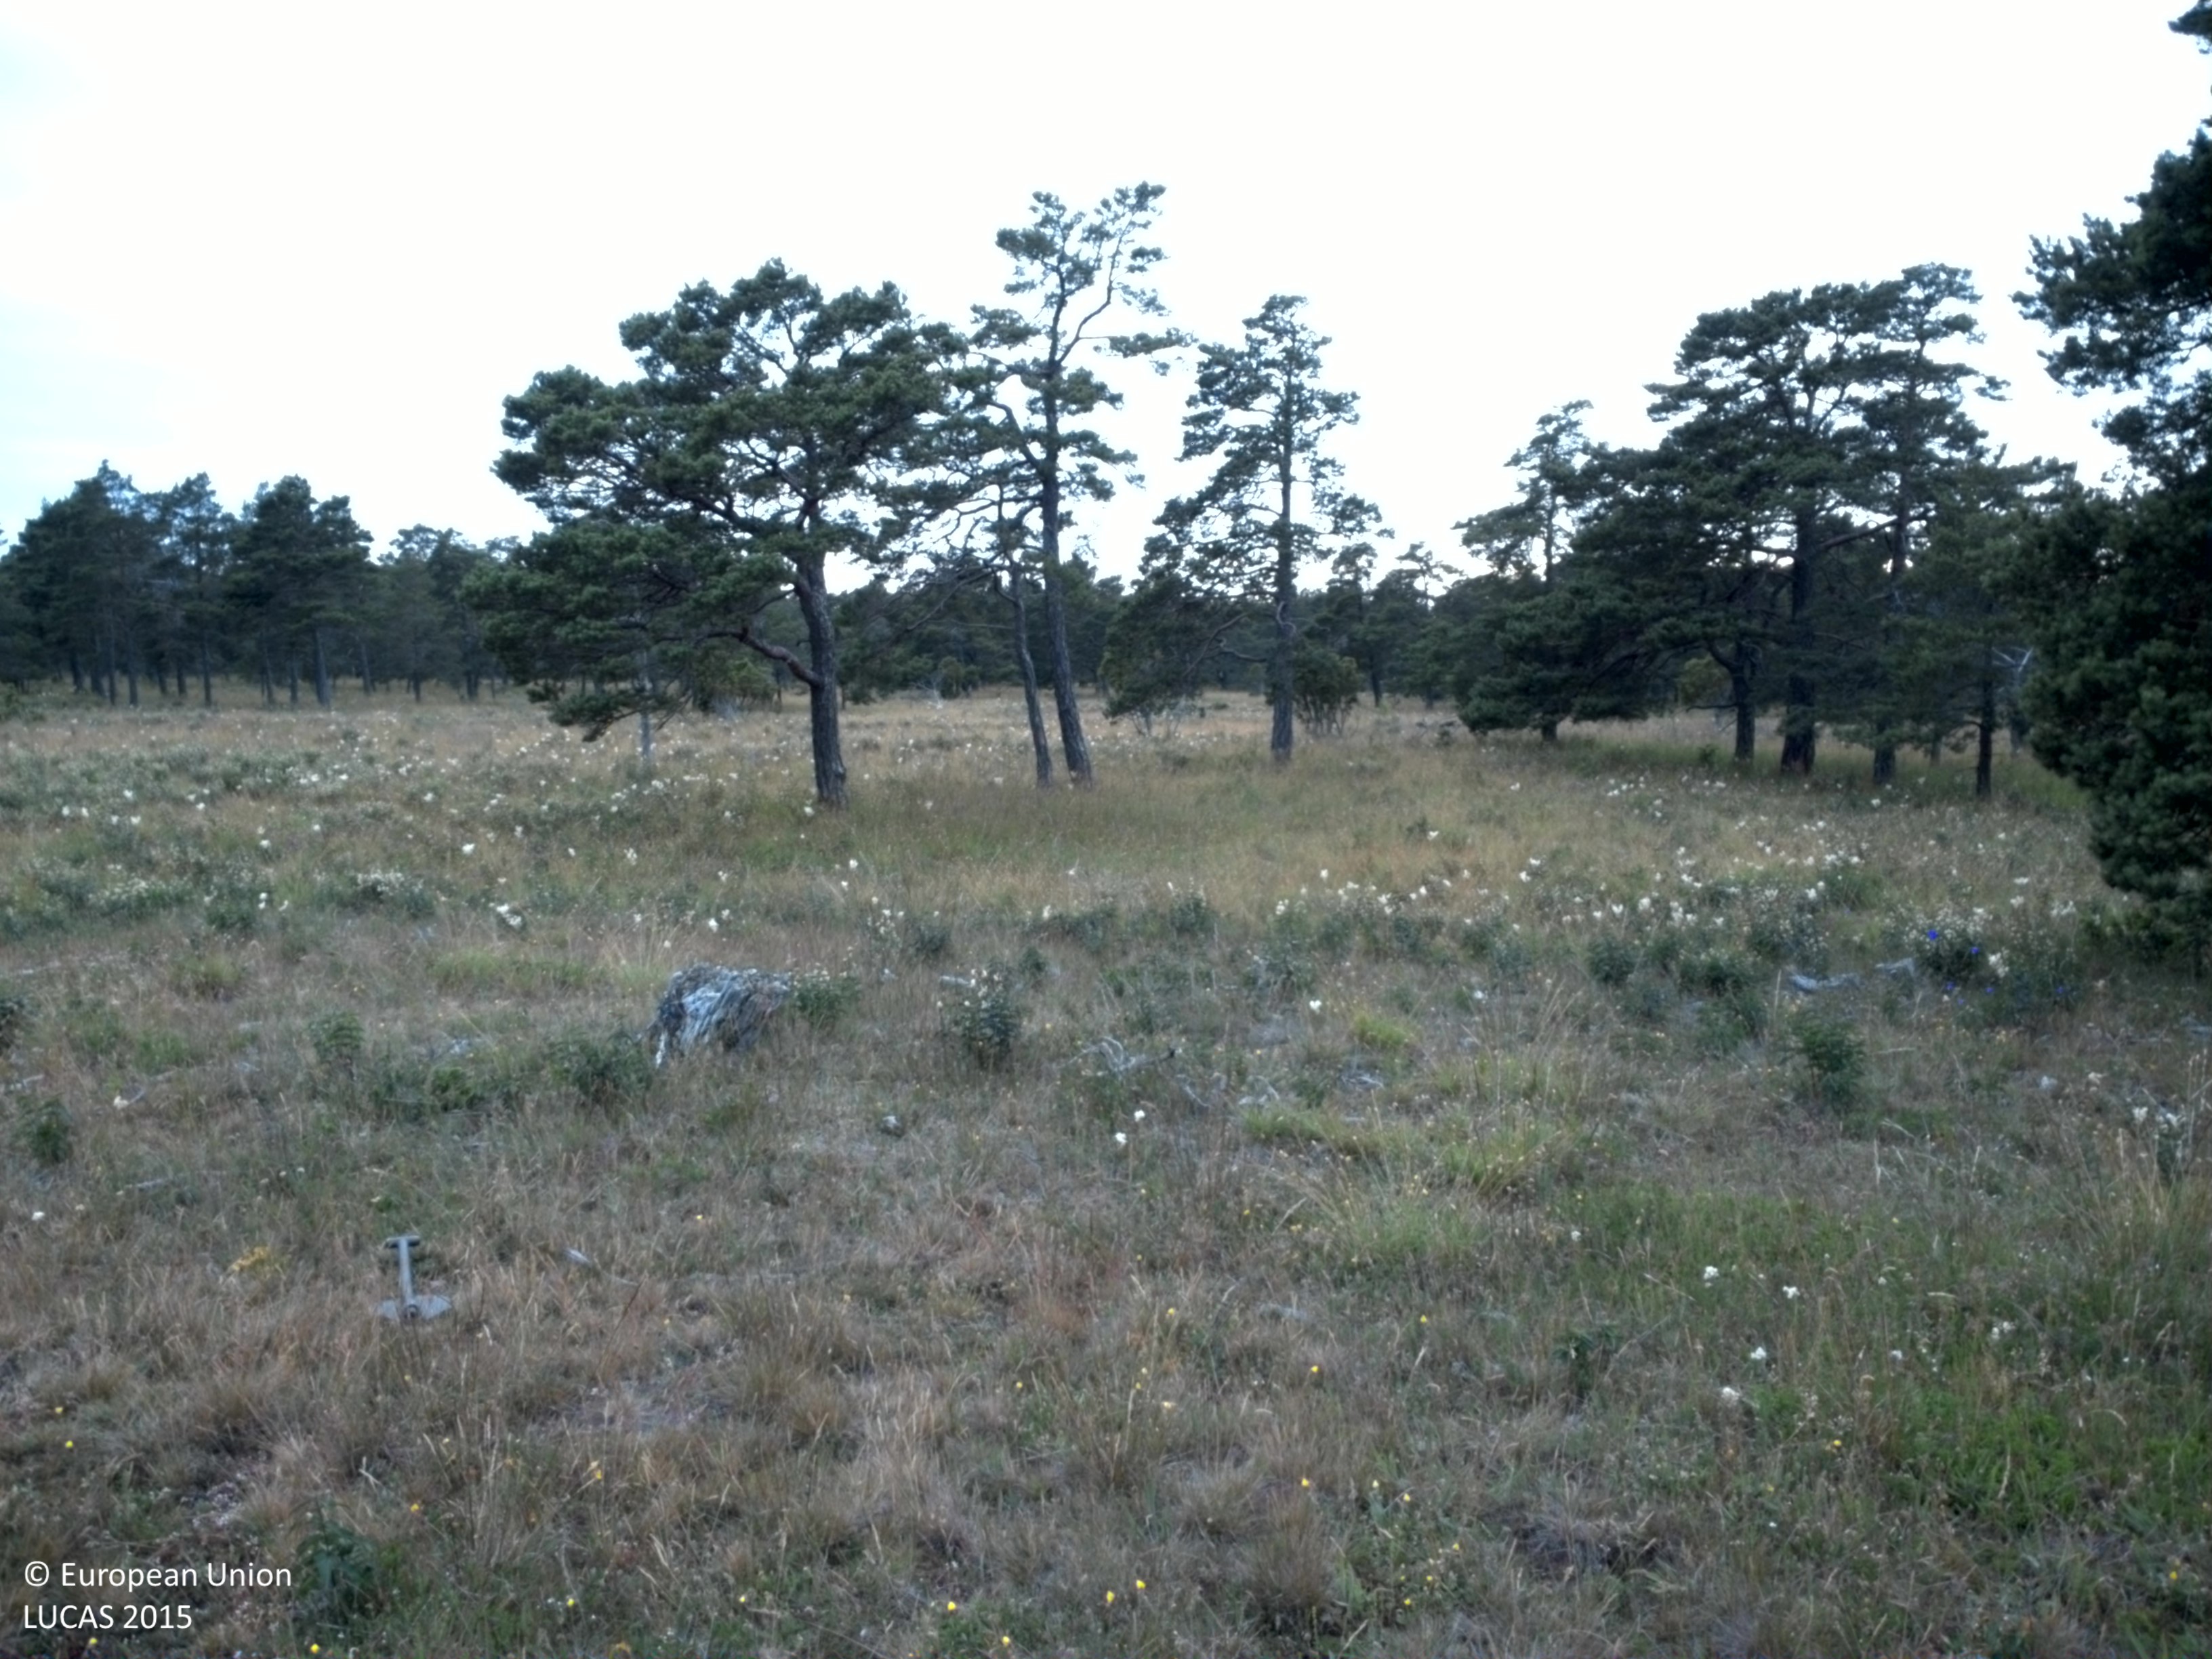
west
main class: Grassland
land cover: Grassland with sparse tree/shrub cover
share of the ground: > 75 %
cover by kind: herbaceous plants 85 %, coniferous forest trees 5 %, shrubs 5 %, lichens and mosses 5 %
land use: Agriculture (excluding fallow land and kitchen gardens)
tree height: > 5 m
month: June
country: SE
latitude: 57.9056
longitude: 18.9029
